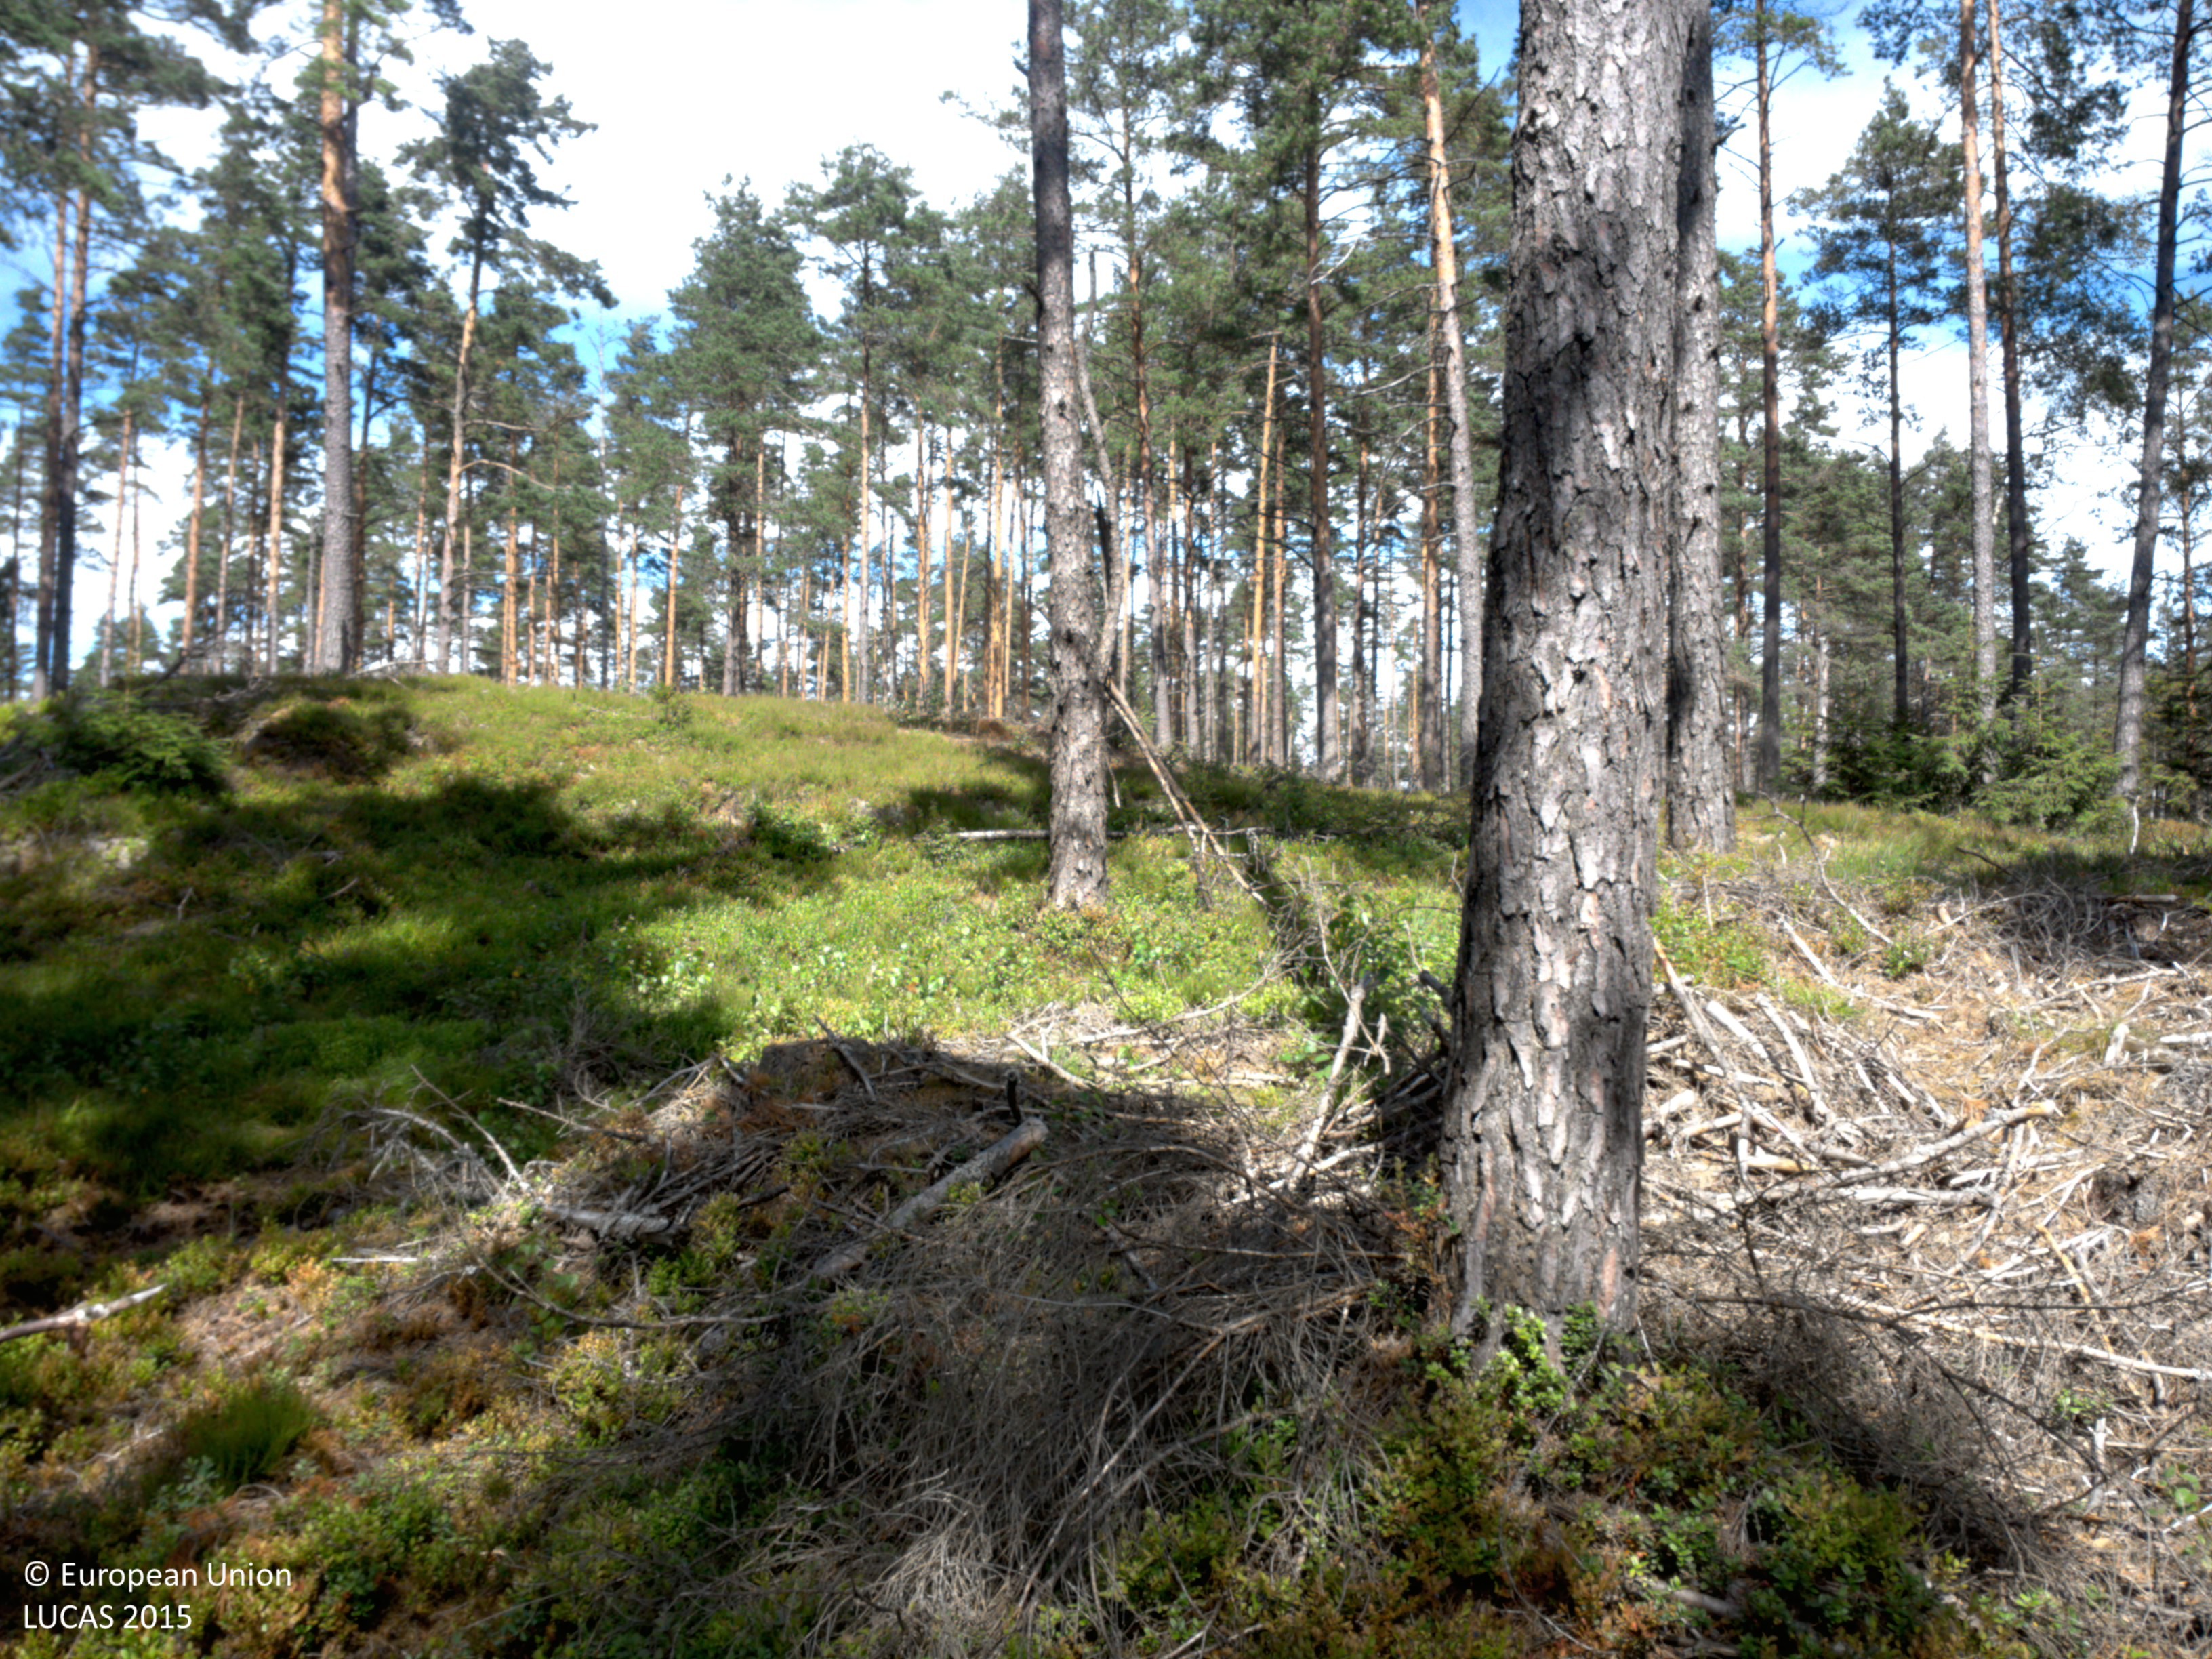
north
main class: Woodland
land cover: Pine dominated coniferous woodland
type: boreal forest
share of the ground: 50 - 75 %
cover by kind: coniferous forest trees 45 %, shrubs 25 %, lichens and mosses 25 %, broadleaved forest trees 5 %
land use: Forestry
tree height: > 5 m
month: July
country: SE
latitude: 58.5672
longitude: 11.8013
